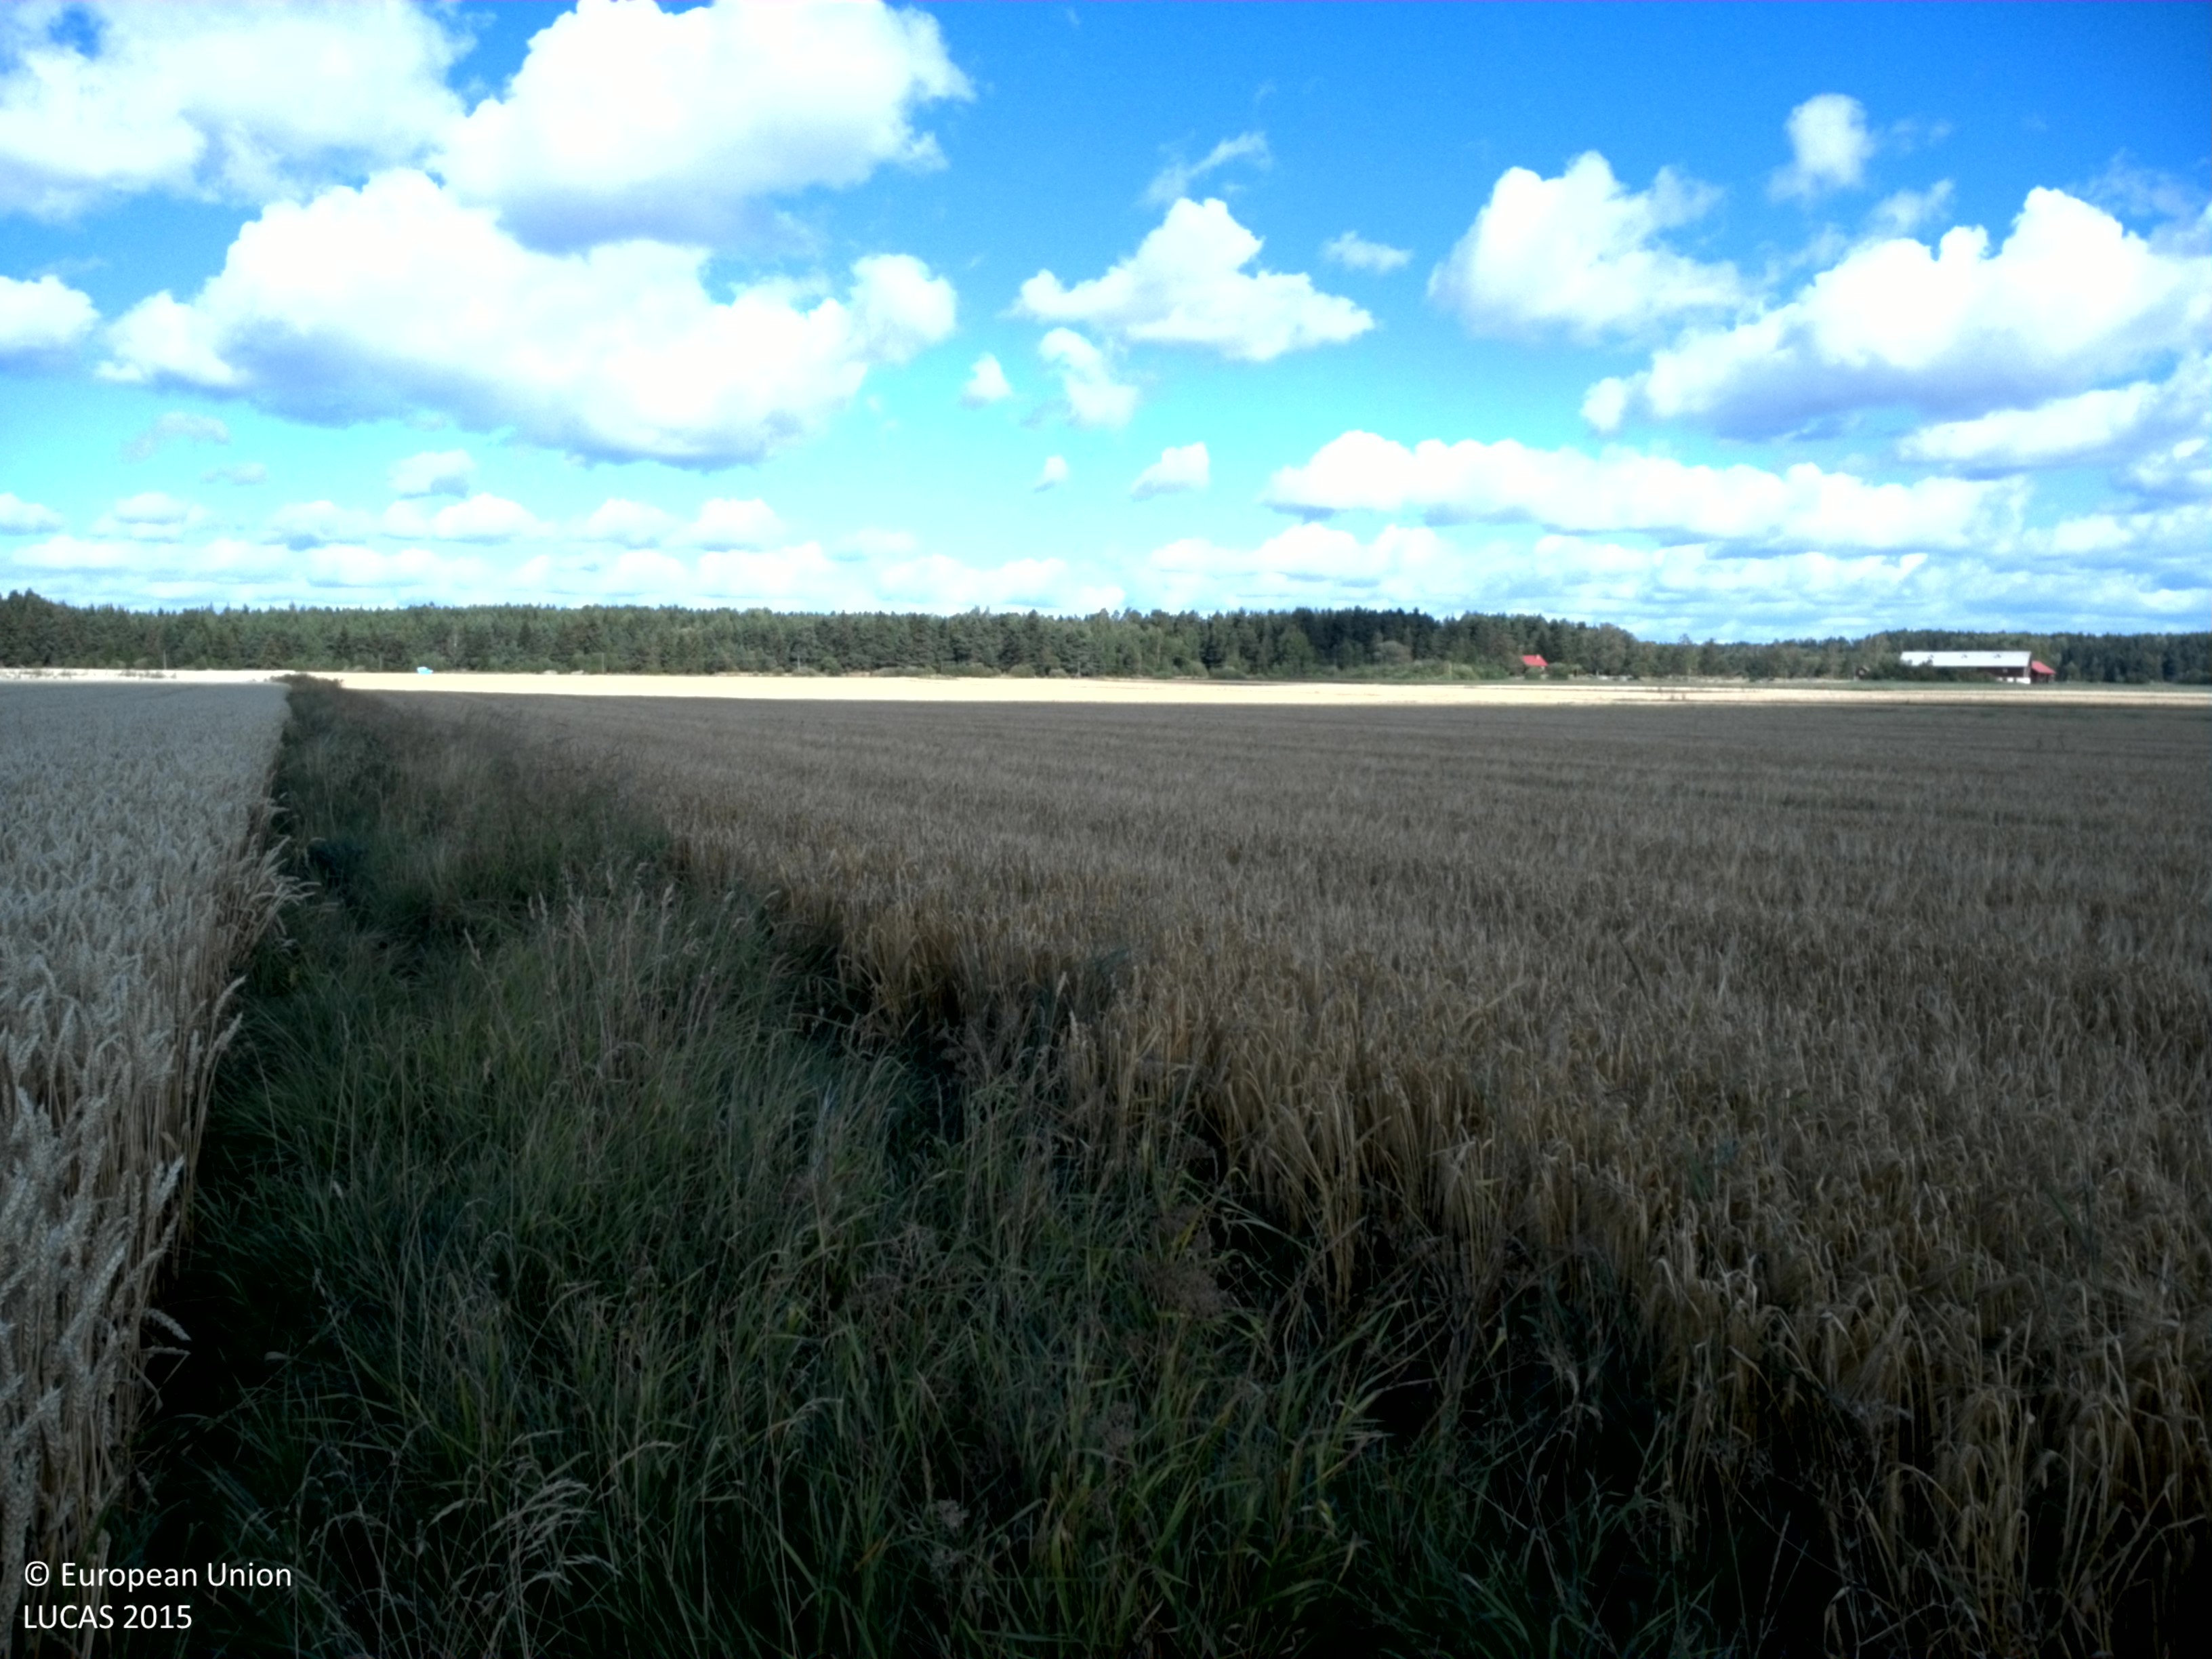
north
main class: Cropland
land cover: Common wheat
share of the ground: > 75 %
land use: Agriculture (excluding fallow land and kitchen gardens)
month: August
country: SE
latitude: 59.7042
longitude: 16.9059
